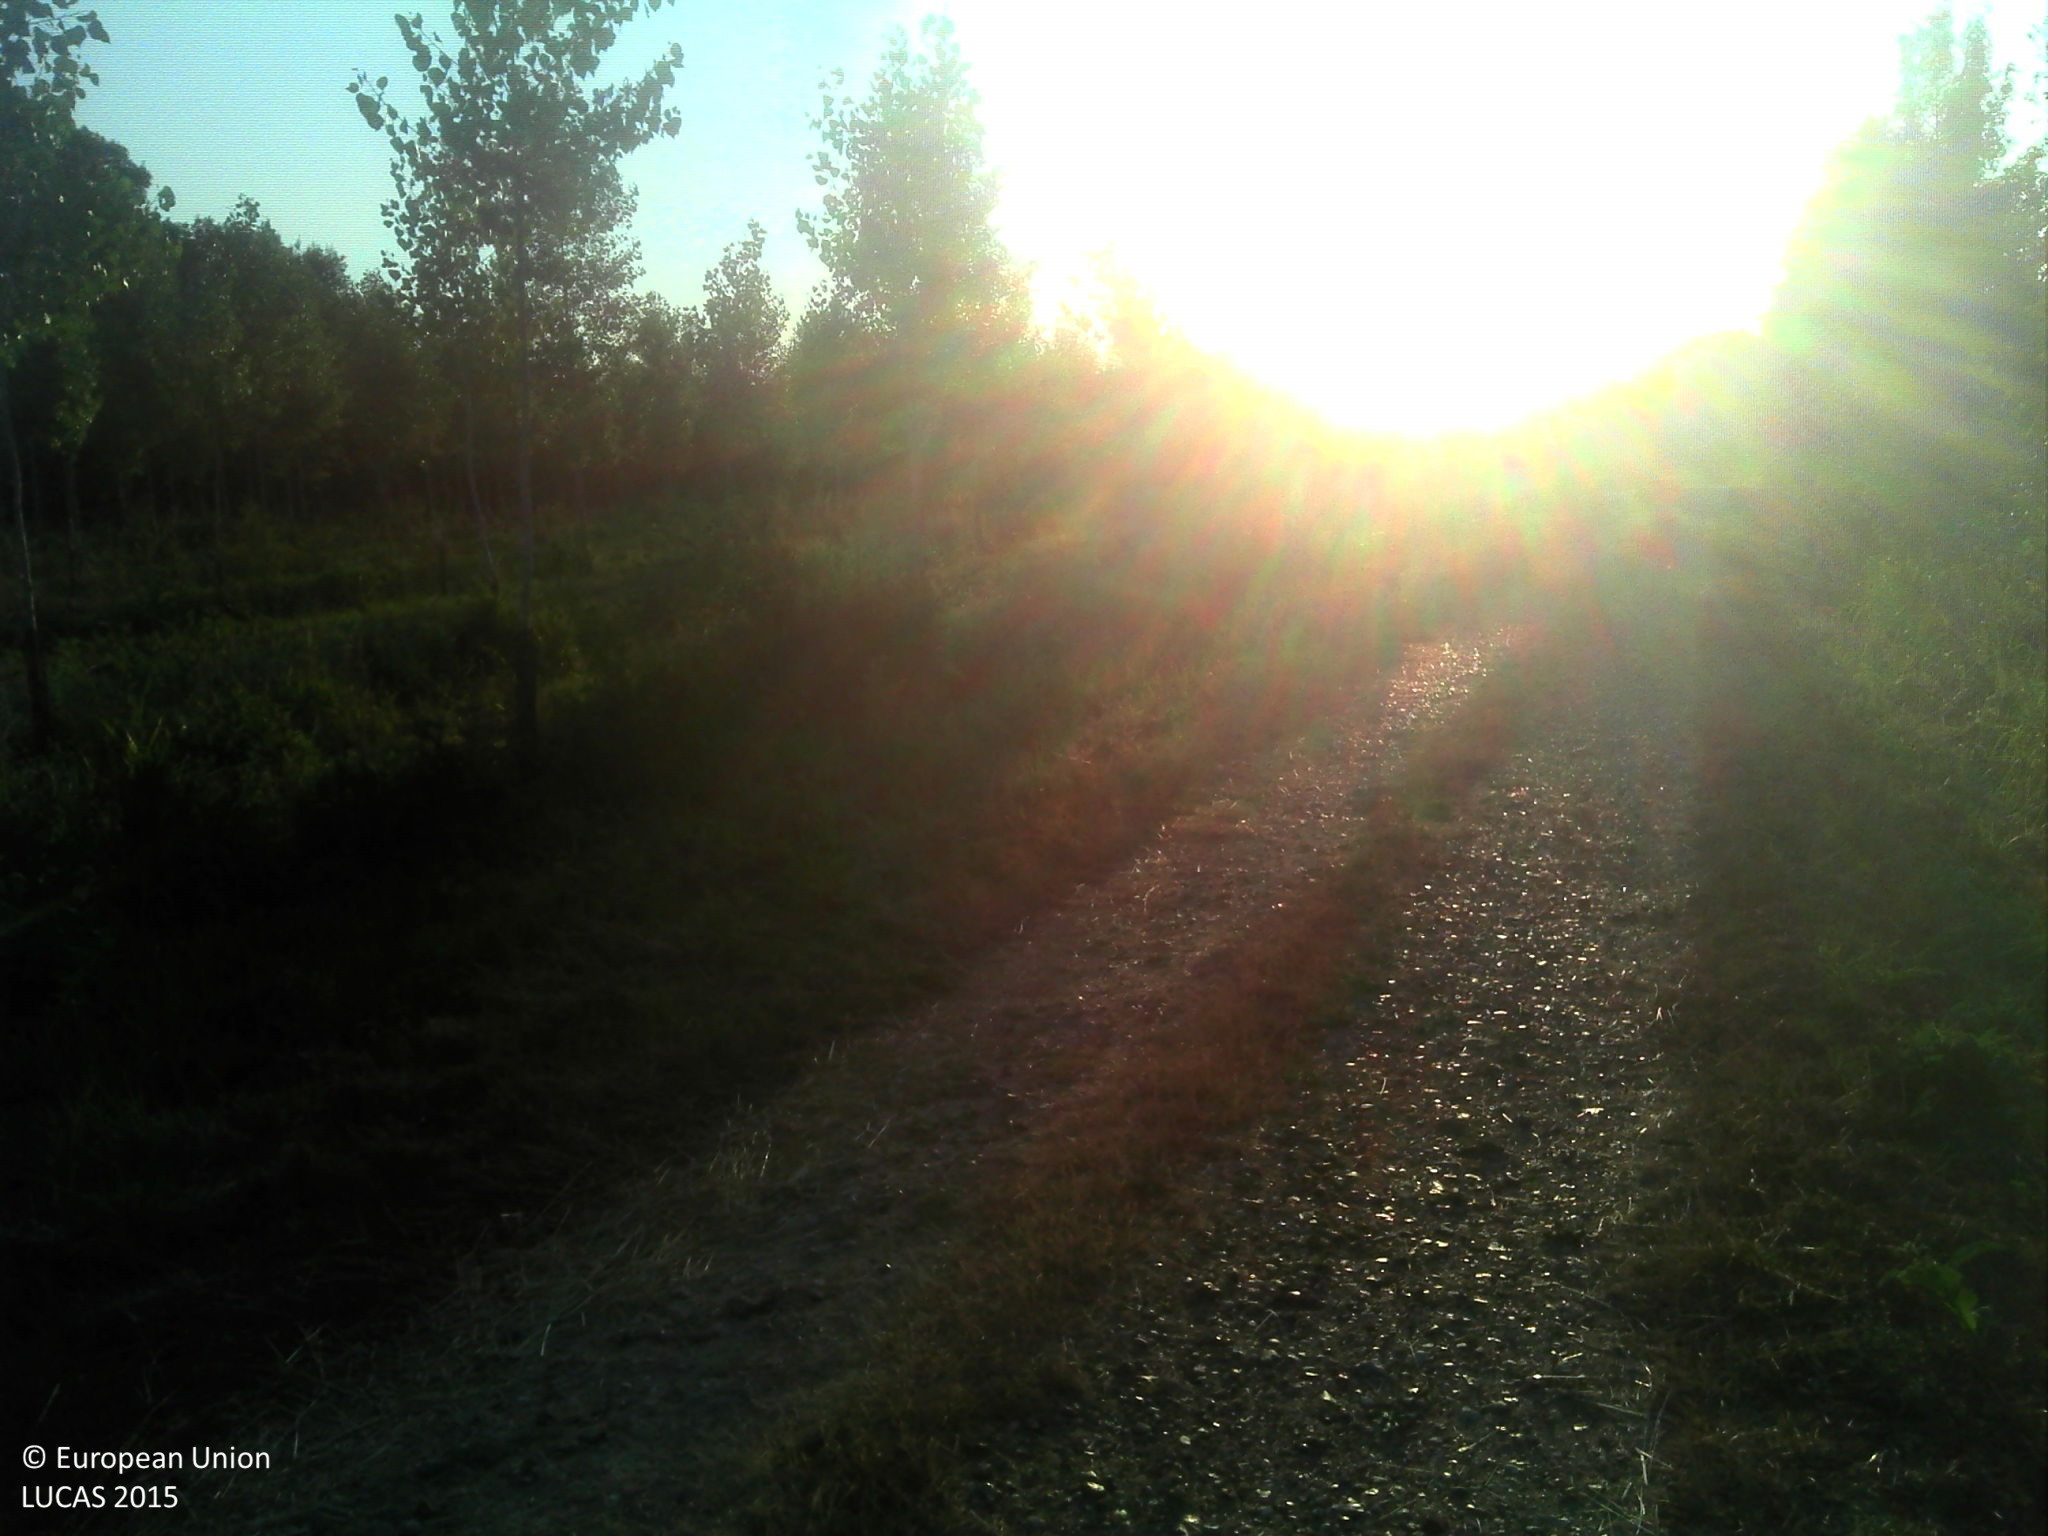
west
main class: Grassland
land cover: Grassland without tree/shrub cover
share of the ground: > 75 %
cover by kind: herbaceous plants 100 %
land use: Agriculture (excluding fallow land and kitchen gardens)
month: July
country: FR
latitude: 47.7958
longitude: 0.7277
